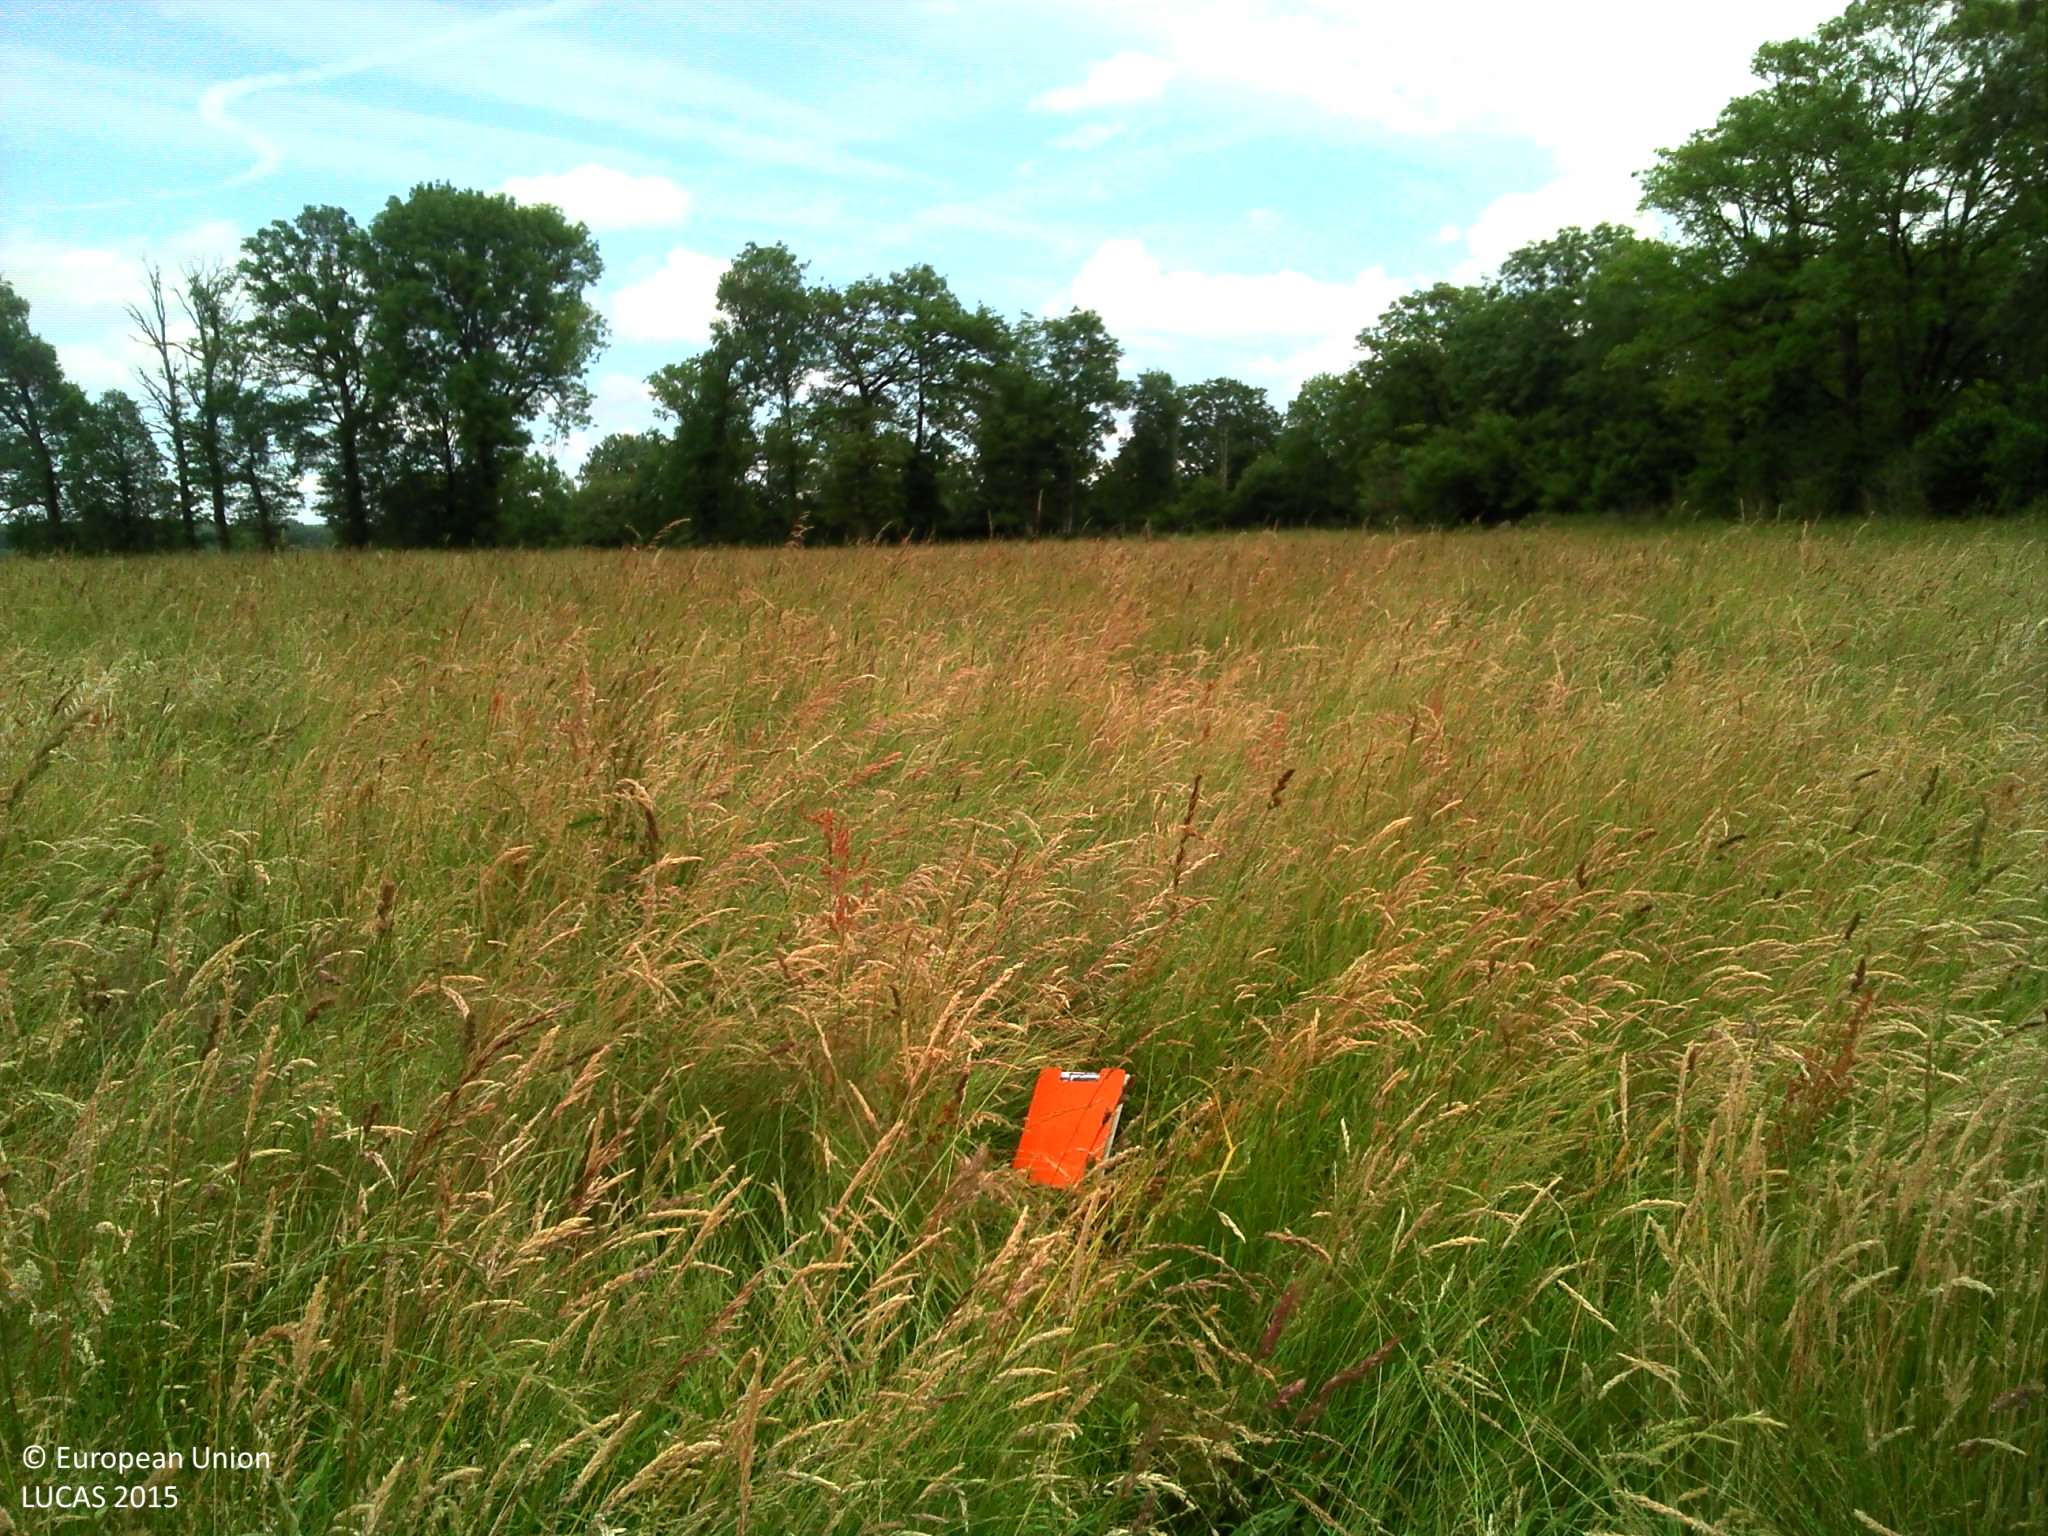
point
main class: Grassland
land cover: Grassland without tree/shrub cover
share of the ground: > 75 %
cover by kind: herbaceous plants 100 %
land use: Agriculture (excluding fallow land and kitchen gardens)
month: June
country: FR
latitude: 45.1904
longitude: 2.3495
